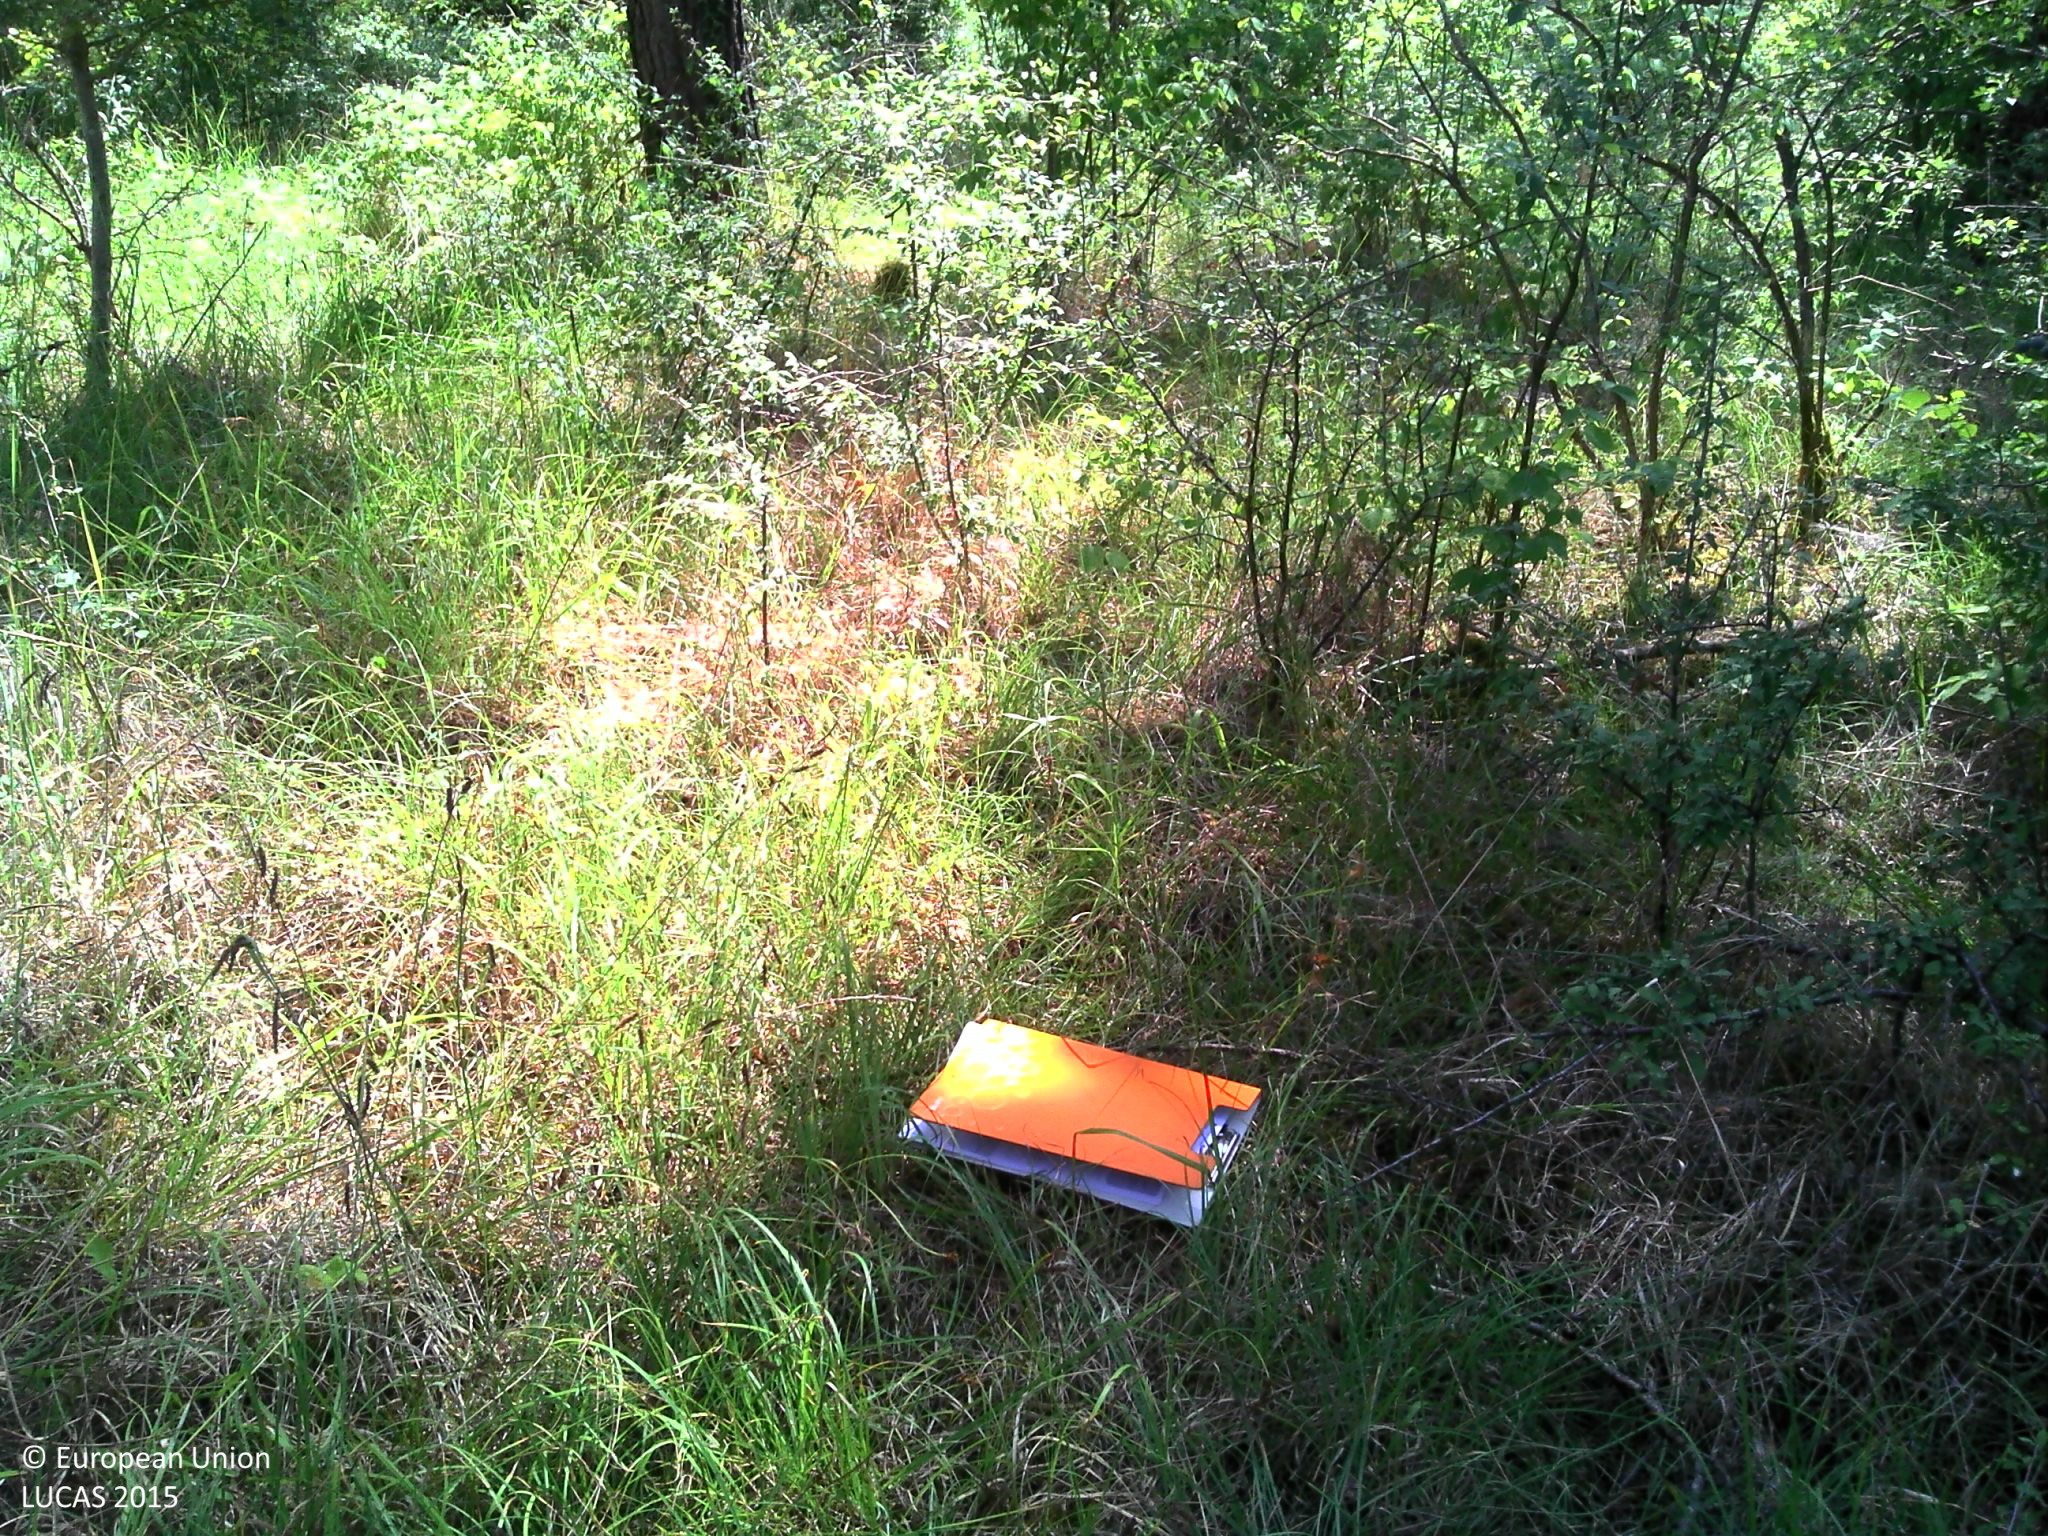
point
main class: Woodland
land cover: Pine dominated coniferous woodland
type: hemiboreal forest and nemoral coniferous forest and mixed broadleaved-coniferous forest
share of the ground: > 75 %
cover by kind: coniferous forest trees 40 %, shrubs 35 %, herbaceous plants 15 %, broadleaved forest trees 5 %, lichens and mosses 5 %
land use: Forestry
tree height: > 5 m
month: July
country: FR
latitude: 48.0612
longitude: 4.7250
